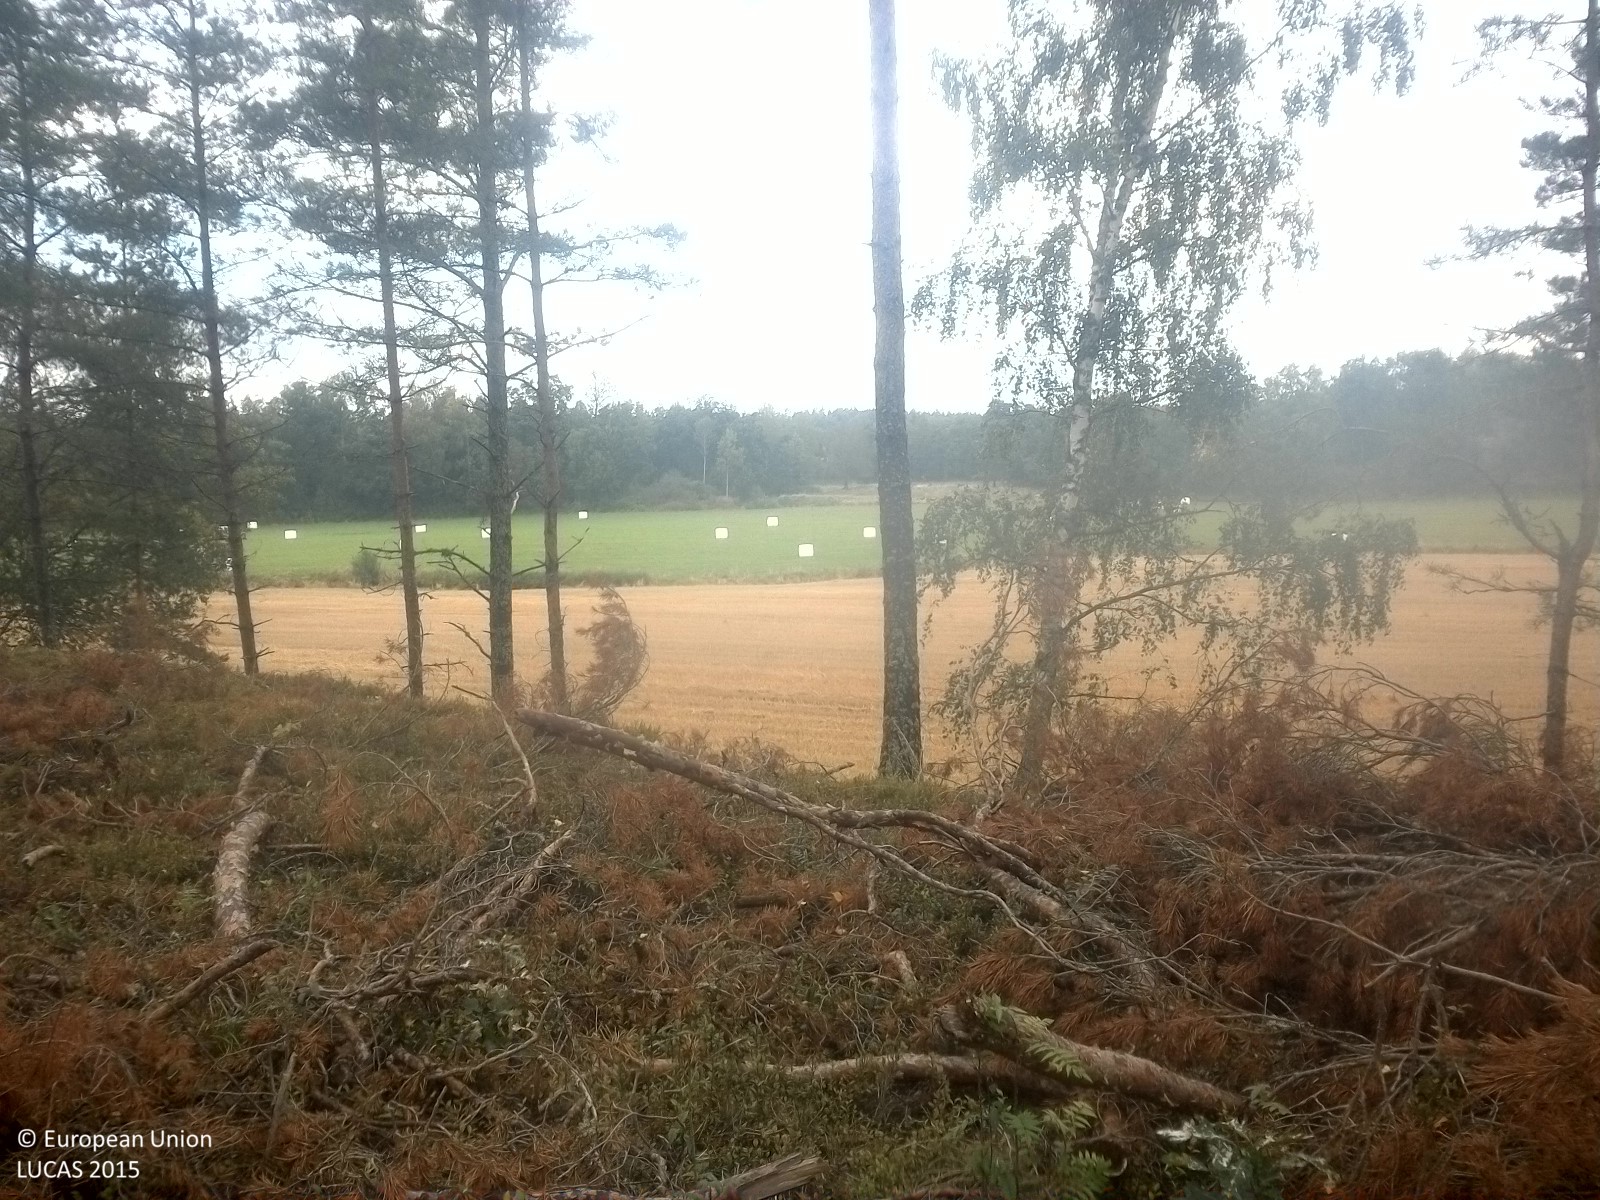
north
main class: Woodland
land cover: Pine dominated coniferous woodland
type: boreal forest
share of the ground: 10 - 25 %
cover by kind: herbaceous plants 55 %, coniferous forest trees 20 %, lichens and mosses 15 %
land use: Forestry
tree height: > 5 m
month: September
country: SE
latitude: 58.5163
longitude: 16.8123
